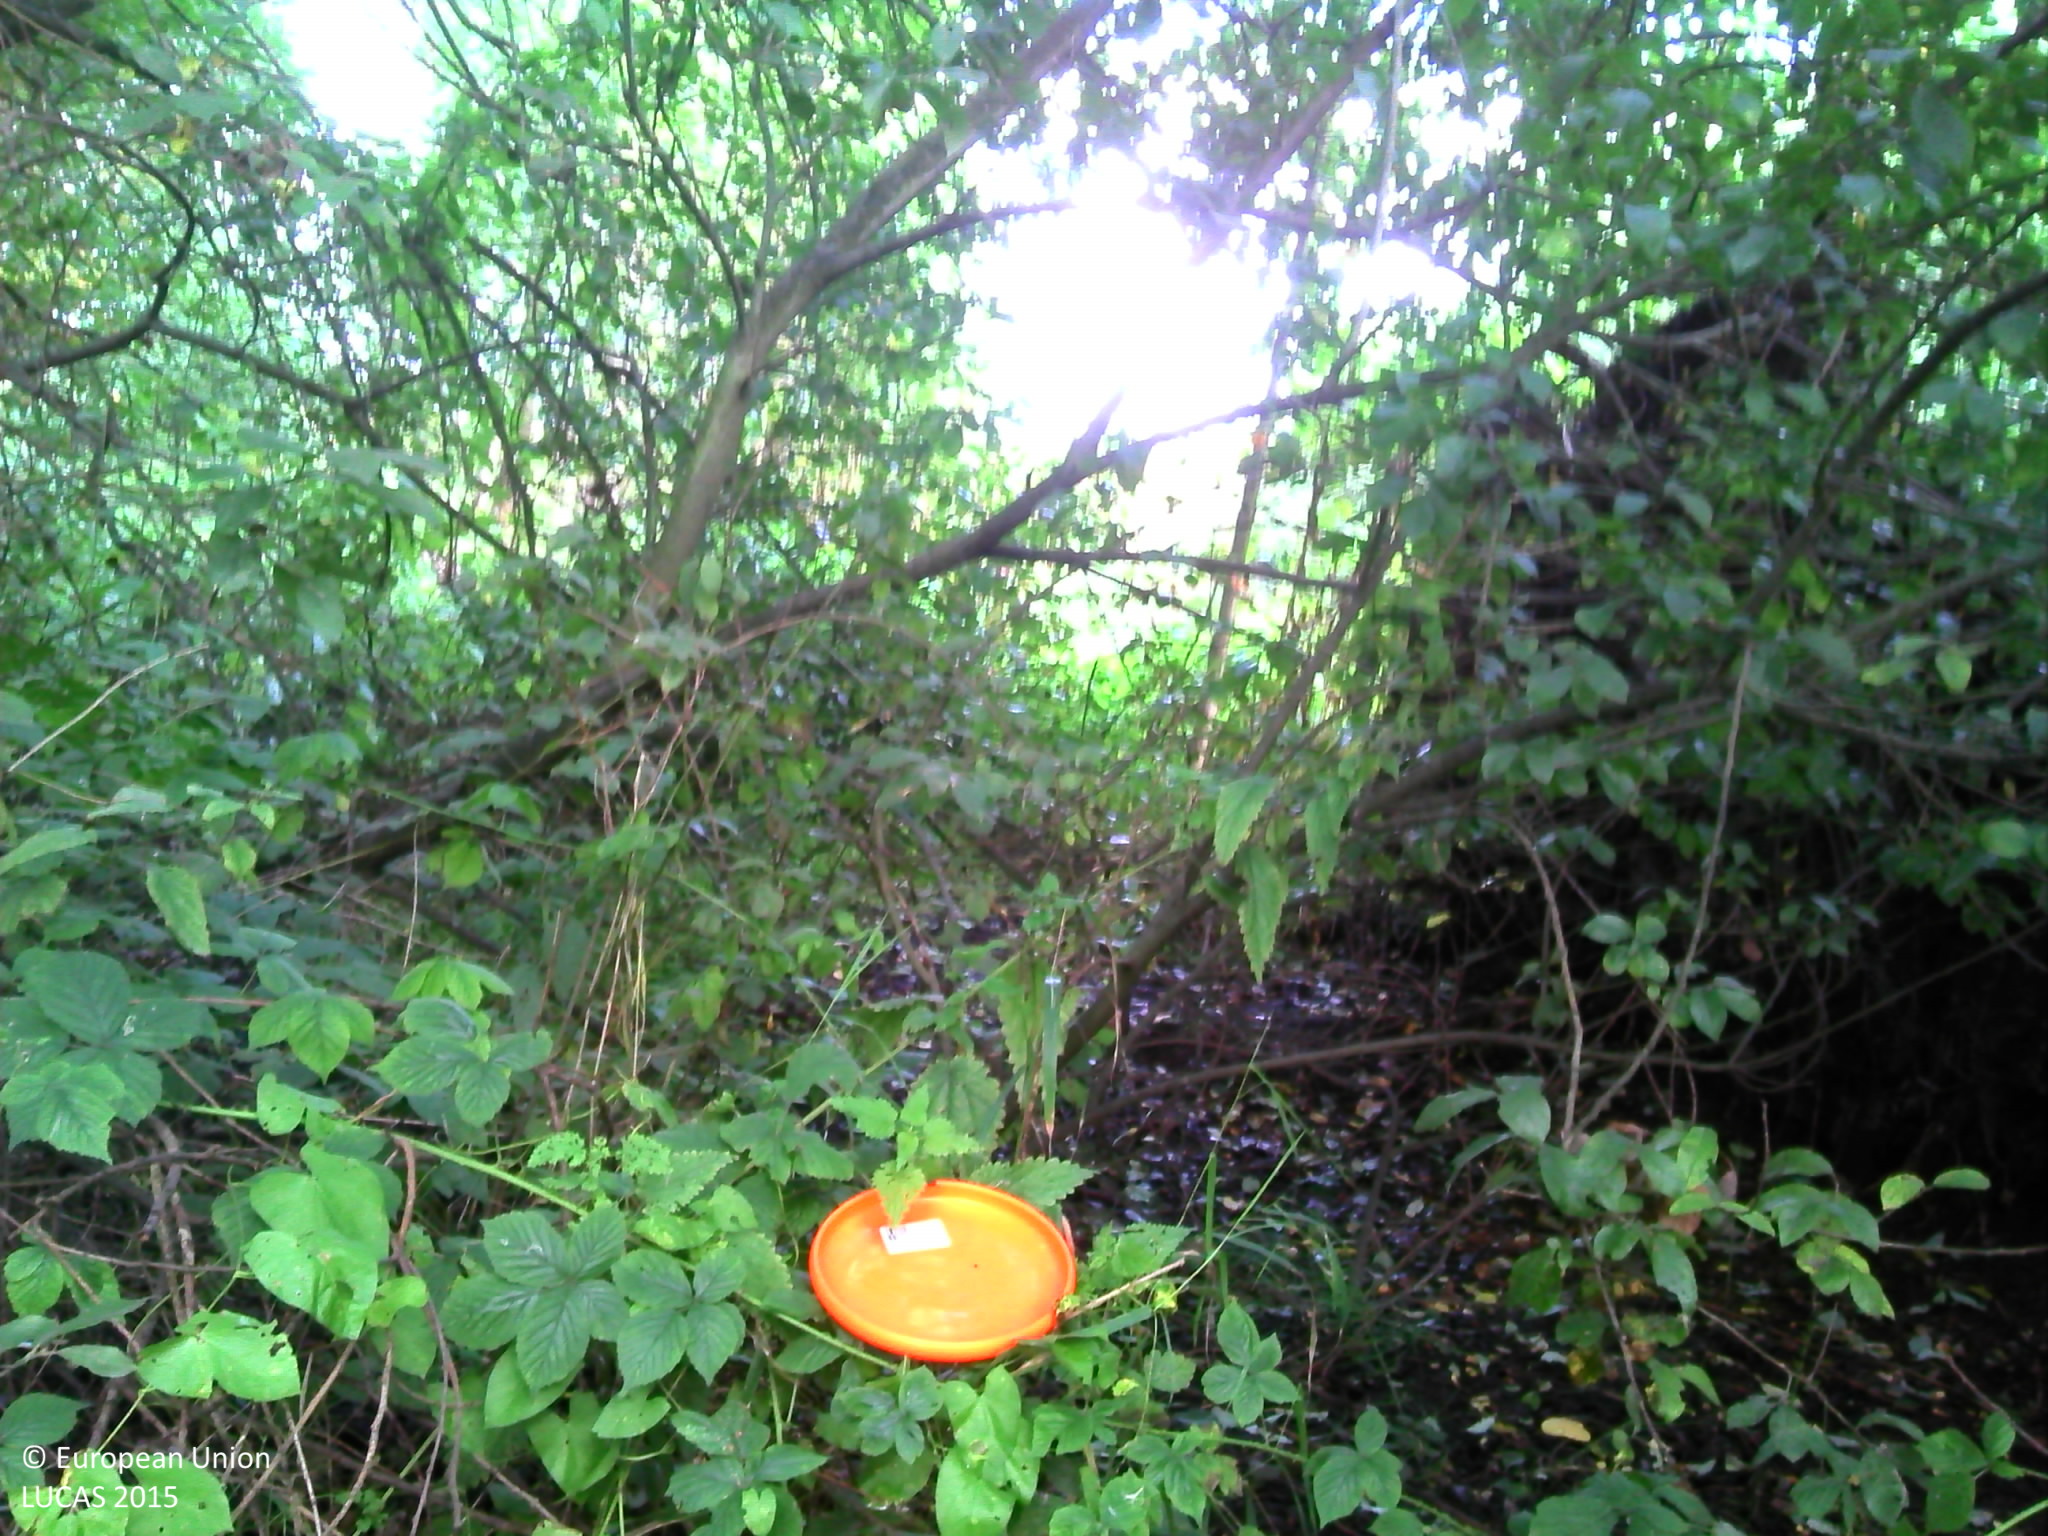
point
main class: Woodland
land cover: Broadleaved woodland
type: floodplain forest
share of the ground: > 75 %
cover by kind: broadleaved forest trees 70 %, herbaceous plants 20 %, shrubs 10 %
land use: Forestry
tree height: > 5 m
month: September
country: BE
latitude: 51.0720
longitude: 4.3579
